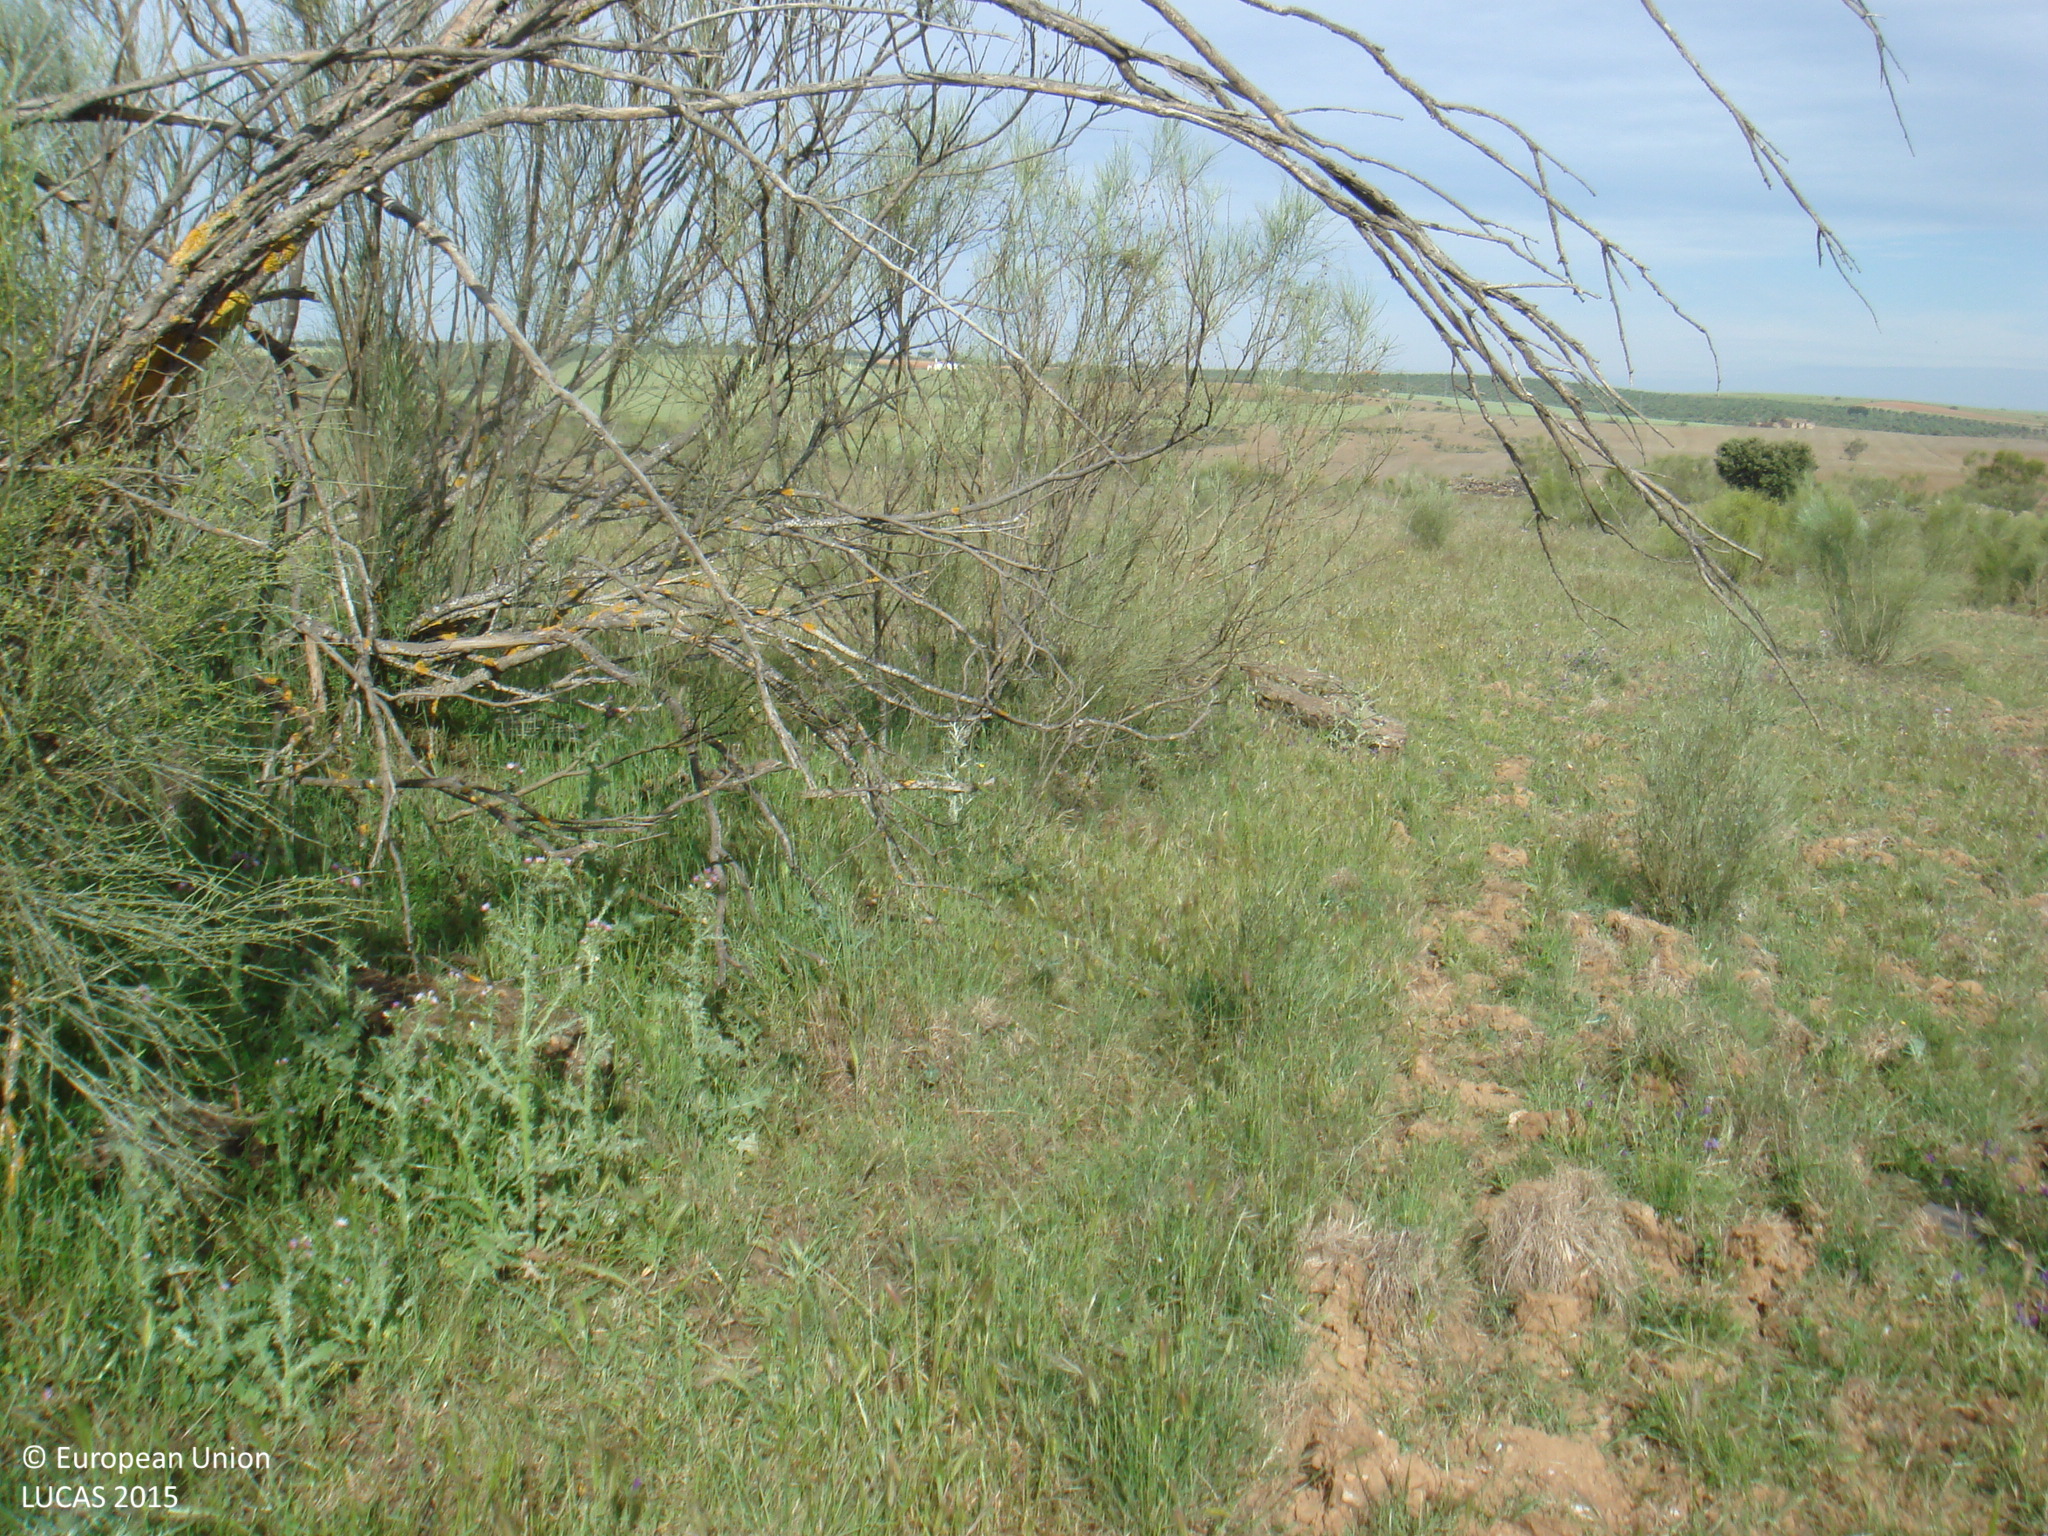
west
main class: Shrubland
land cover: Shrubland without tree cover
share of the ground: > 75 %
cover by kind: herbaceous plants 70 %, shrubs 30 %
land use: Semi-natural and natural areas not in use
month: May
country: ES
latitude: 38.4307
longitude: -5.0917
